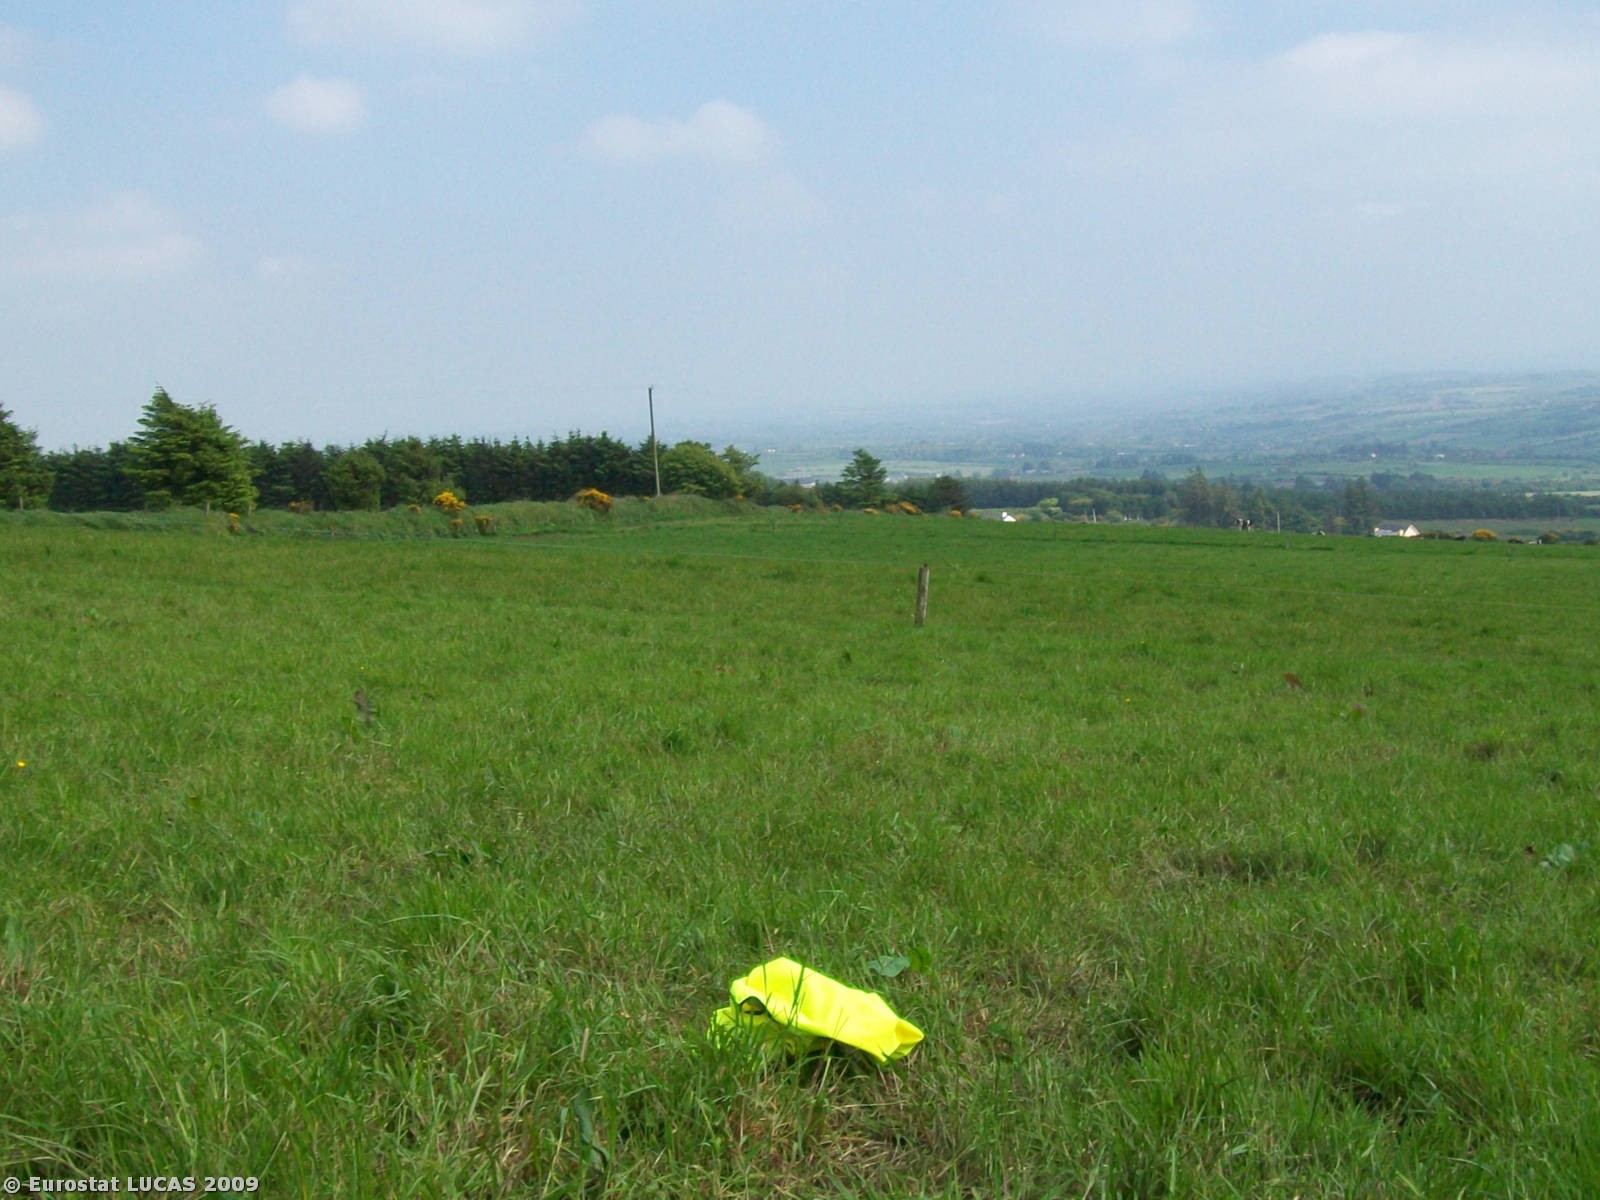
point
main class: Grassland
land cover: Grassland without tree/shrub cover
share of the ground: > 75 %
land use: Agriculture (excluding fallow land and kitchen gardens)
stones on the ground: < 10 %
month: May
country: IE
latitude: 52.0222
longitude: -8.7854
